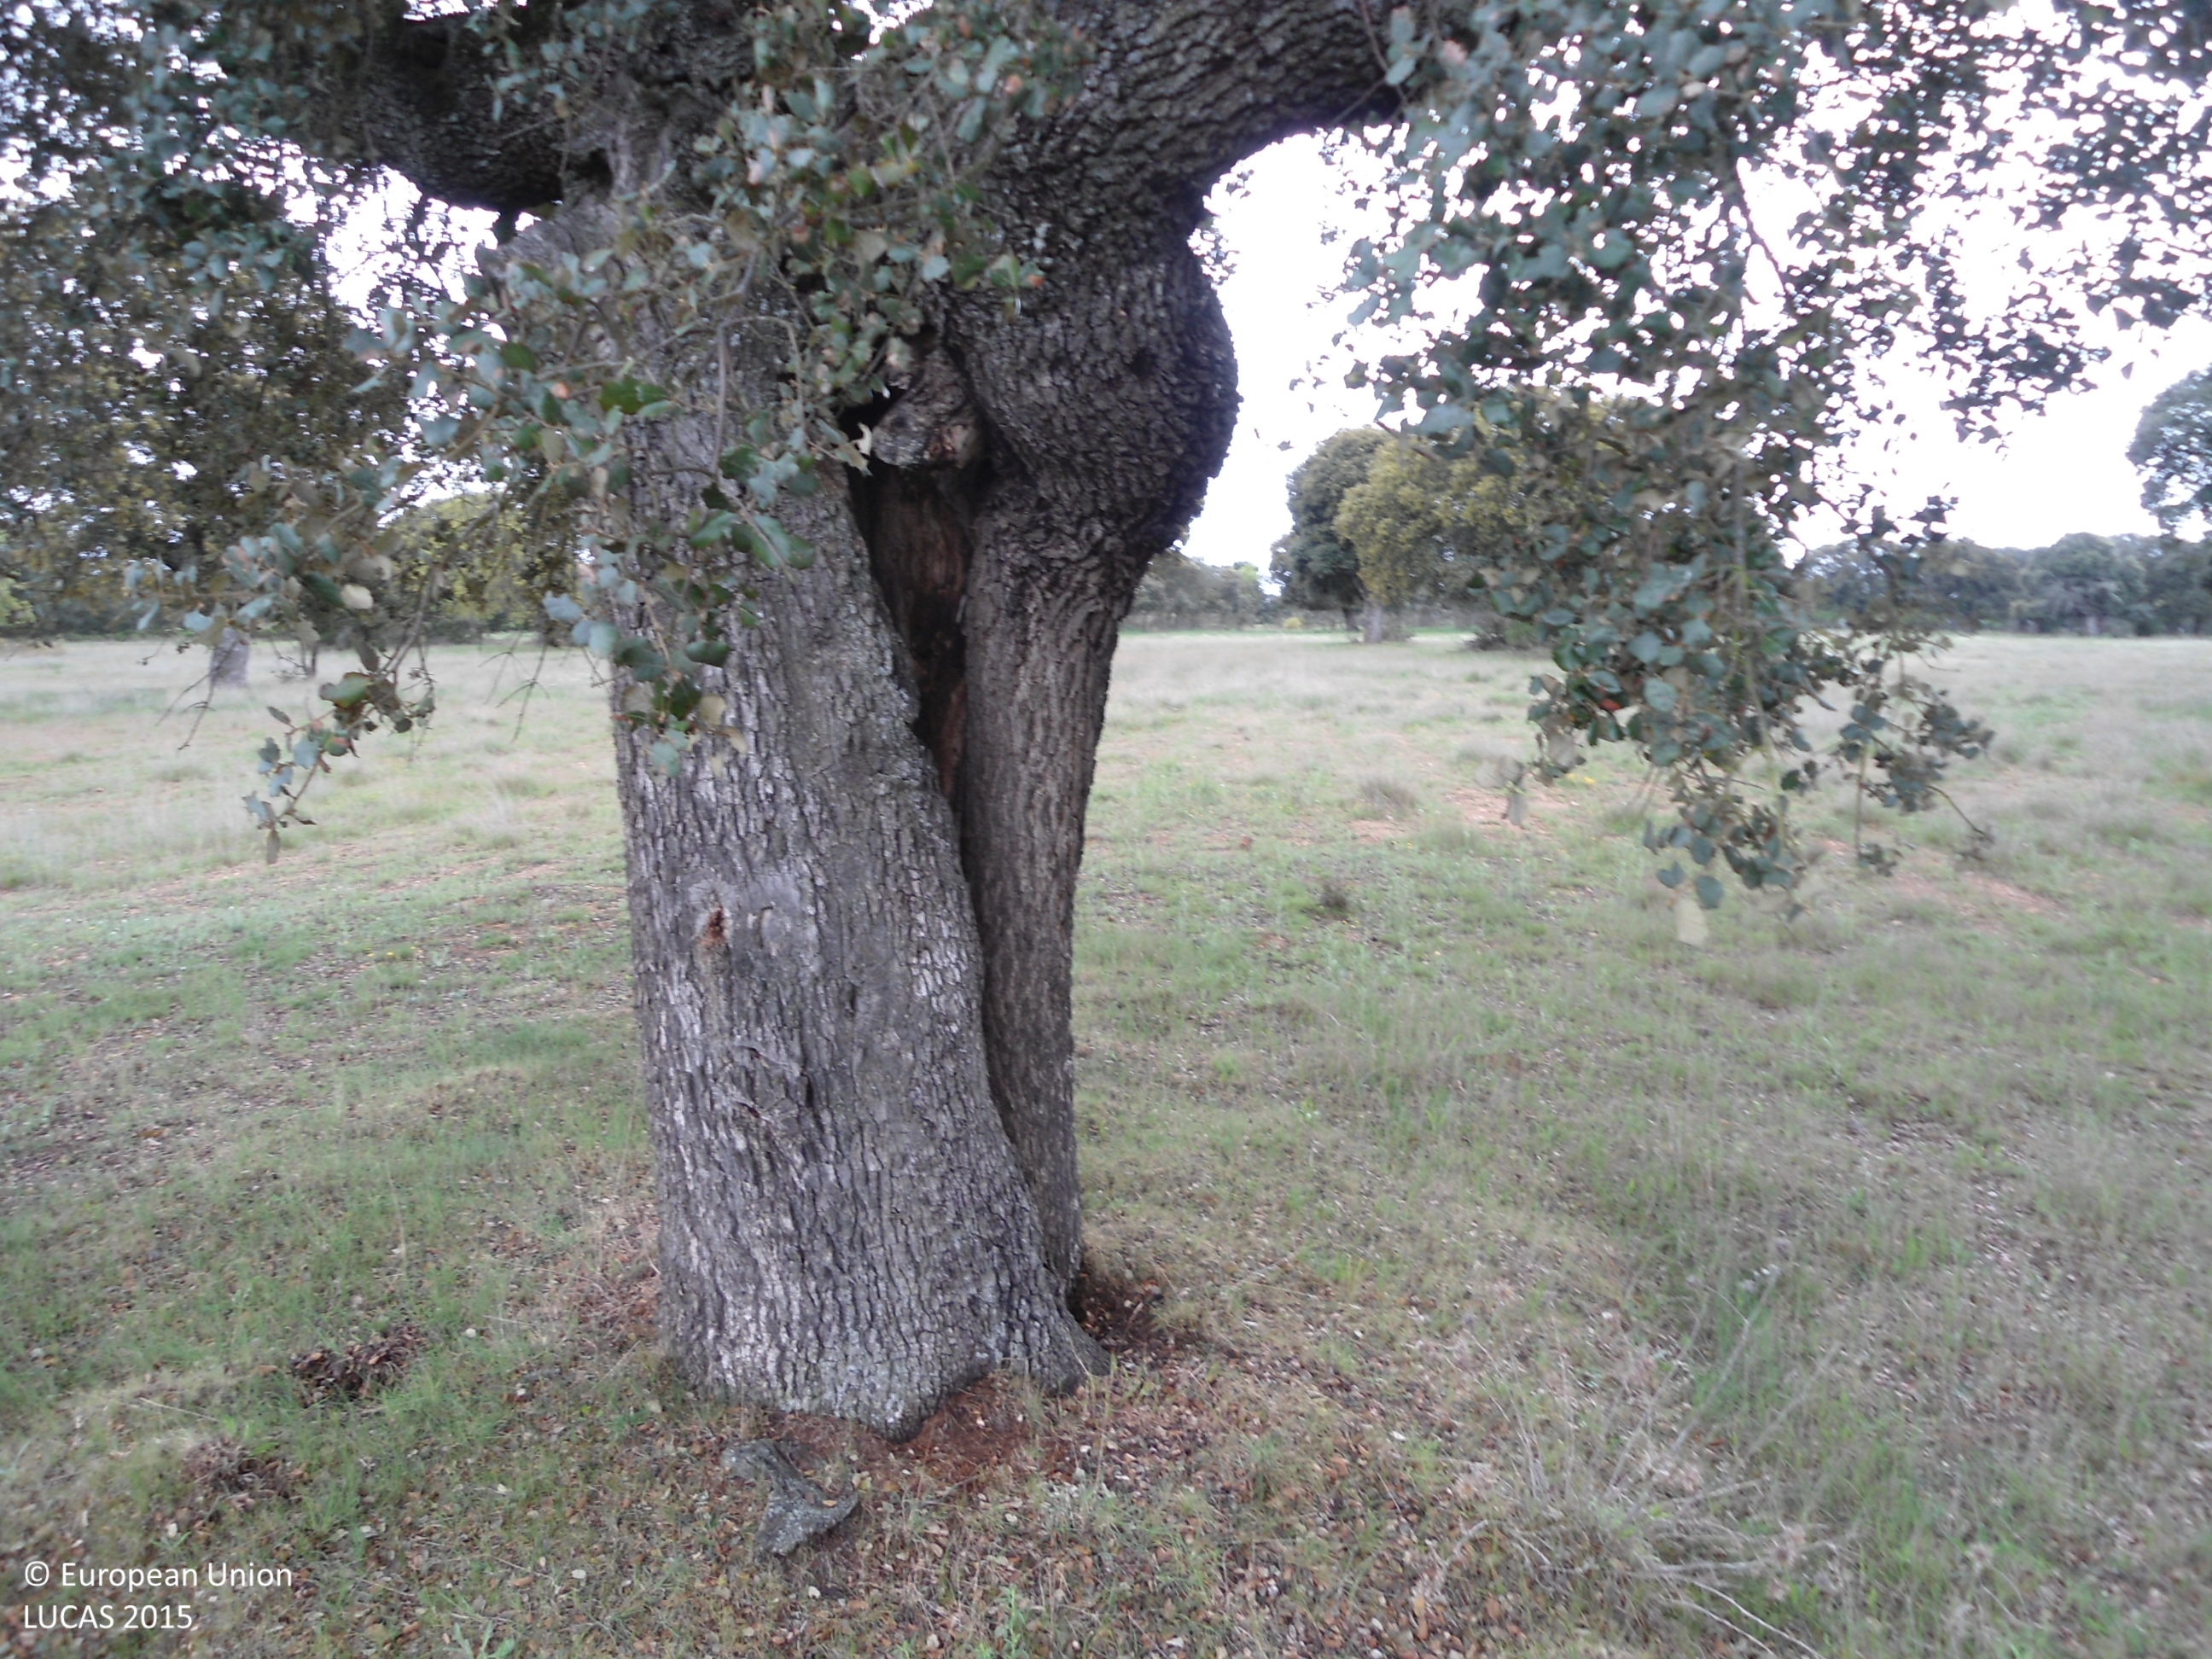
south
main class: Woodland
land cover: Broadleaved woodland
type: broadleaved evergreen forest
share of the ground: 25 - 50 %
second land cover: Grassland without tree/shrub cover
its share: 50 - 75 %
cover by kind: herbaceous plants 55 %, broadleaved forest trees 40 %, shrubs 5 %
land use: Forestry
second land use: Agriculture (excluding fallow land and kitchen gardens)
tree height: > 5 m
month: May
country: ES
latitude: 41.8114
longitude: -5.8989
